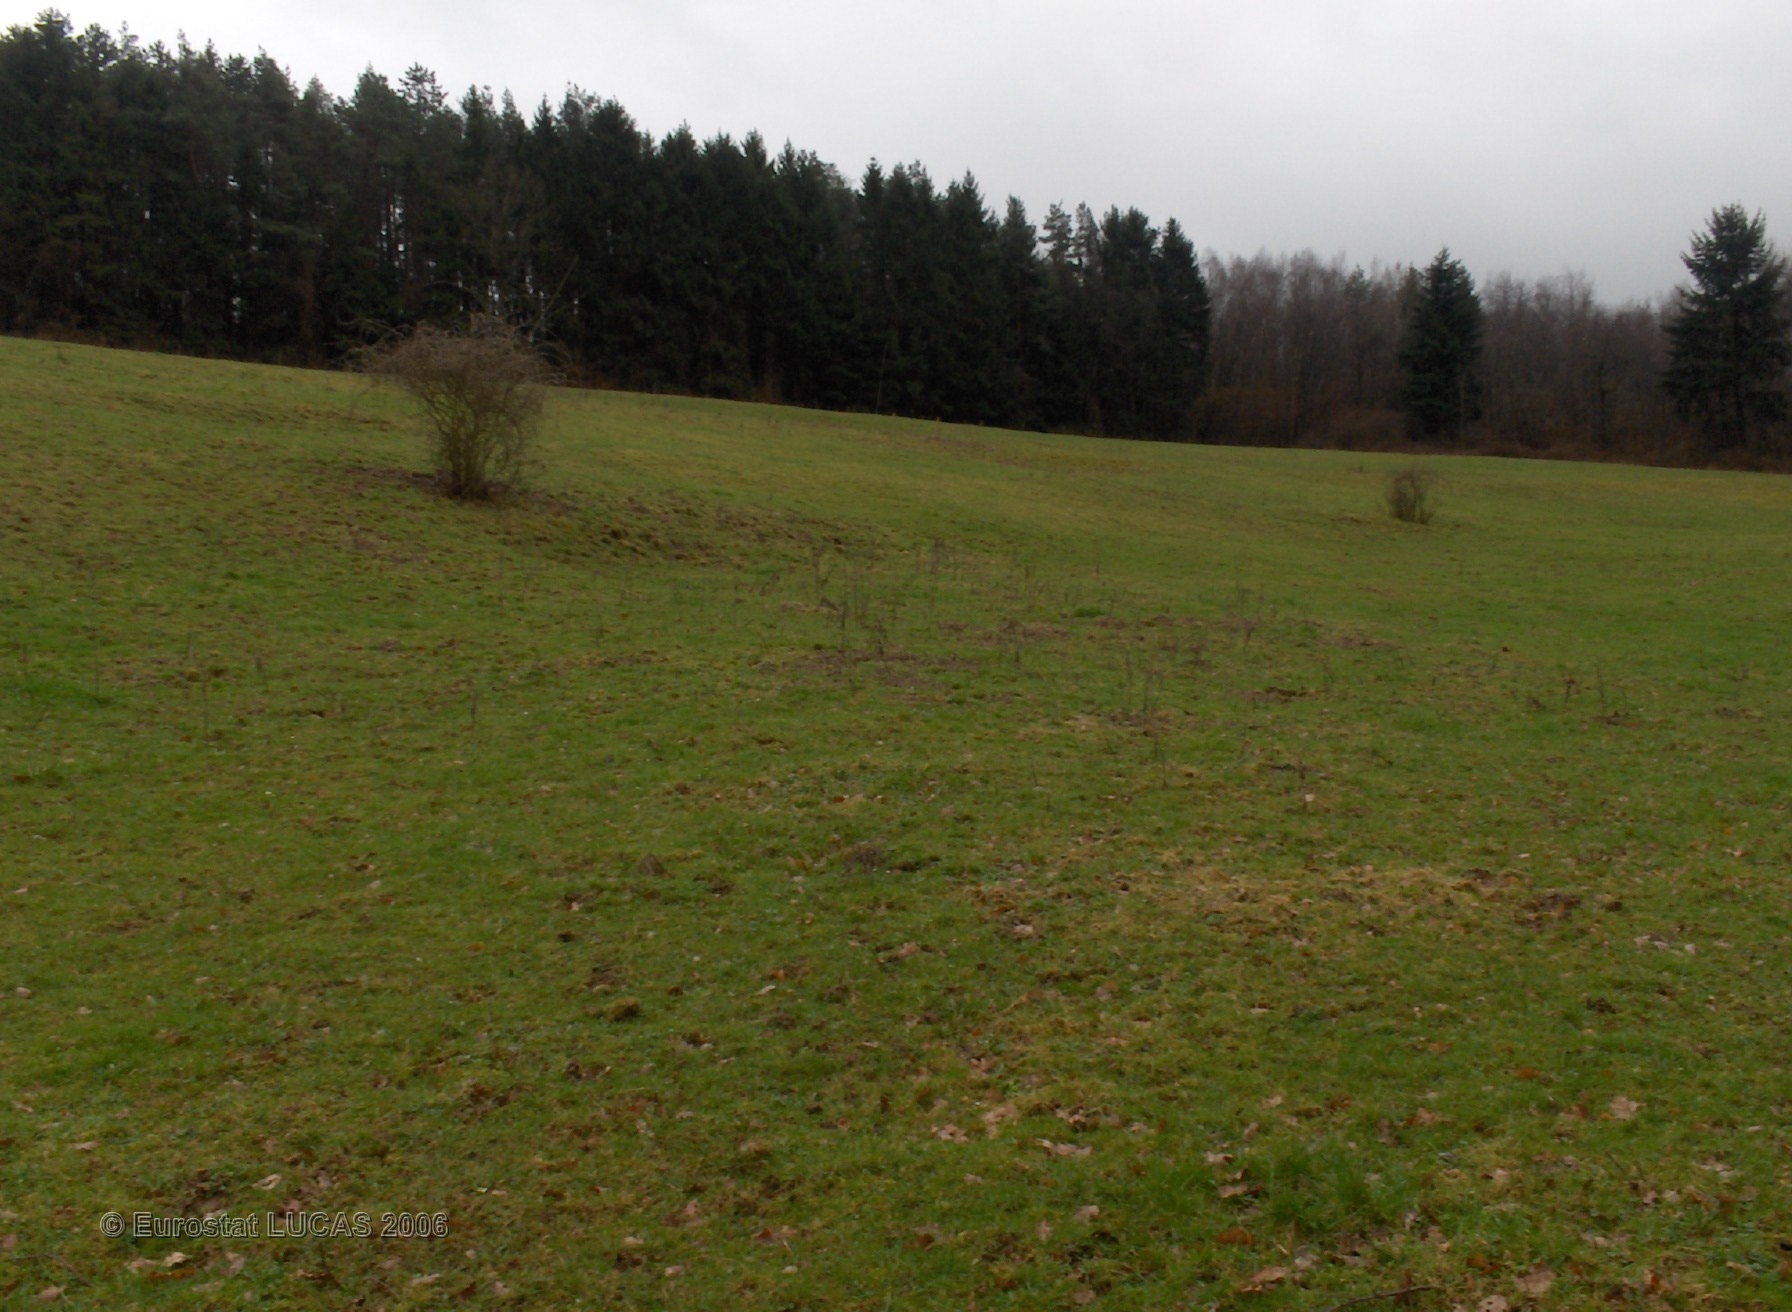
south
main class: Grassland
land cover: Grassland with sparse tree/shrub cover
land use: Agriculture (excluding fallow land and kitchen gardens)
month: April
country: BE
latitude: 50.2125
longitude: 5.2754
